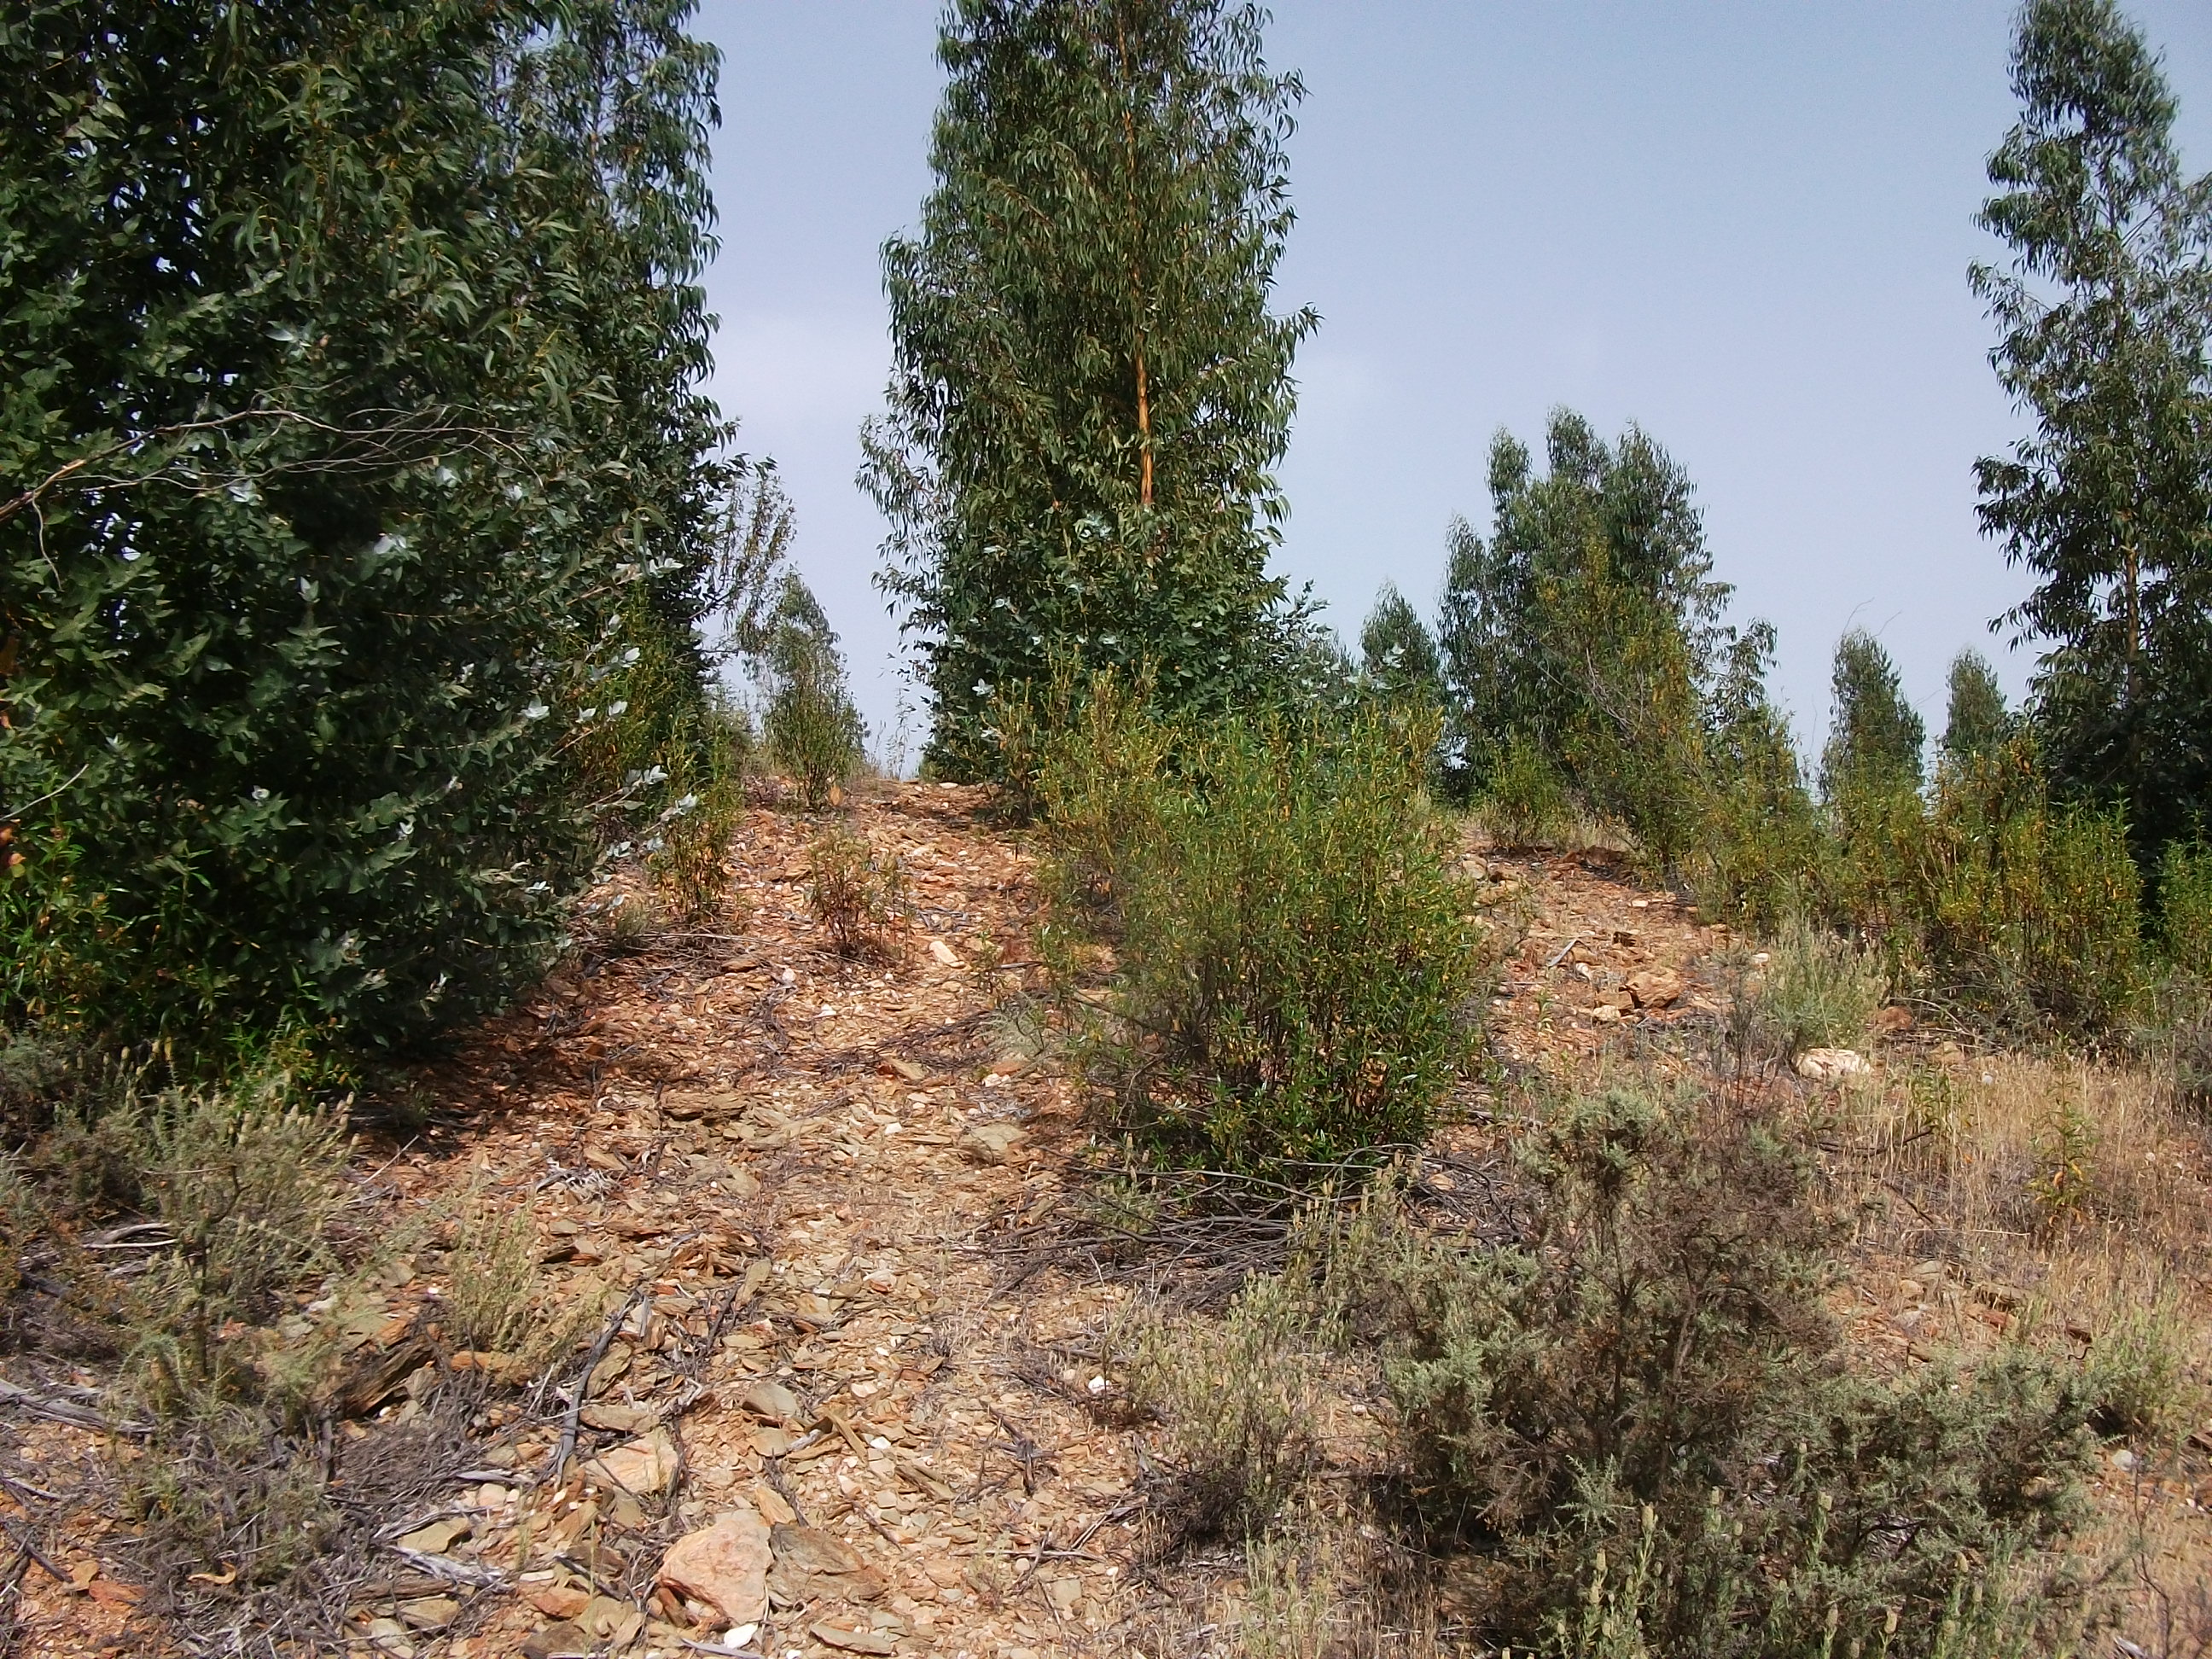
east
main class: Woodland
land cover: Broadleaved woodland
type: exotic forest
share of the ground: 50 - 75 %
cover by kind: broadleaved forest trees 60 %, shrubs 30 %, herbaceous plants 5 %, unconsolidated bare surface 5 %
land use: Forestry
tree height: > 5 m
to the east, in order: Broadleaved woodland
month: May
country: ES
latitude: 37.7043
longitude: -6.9822
